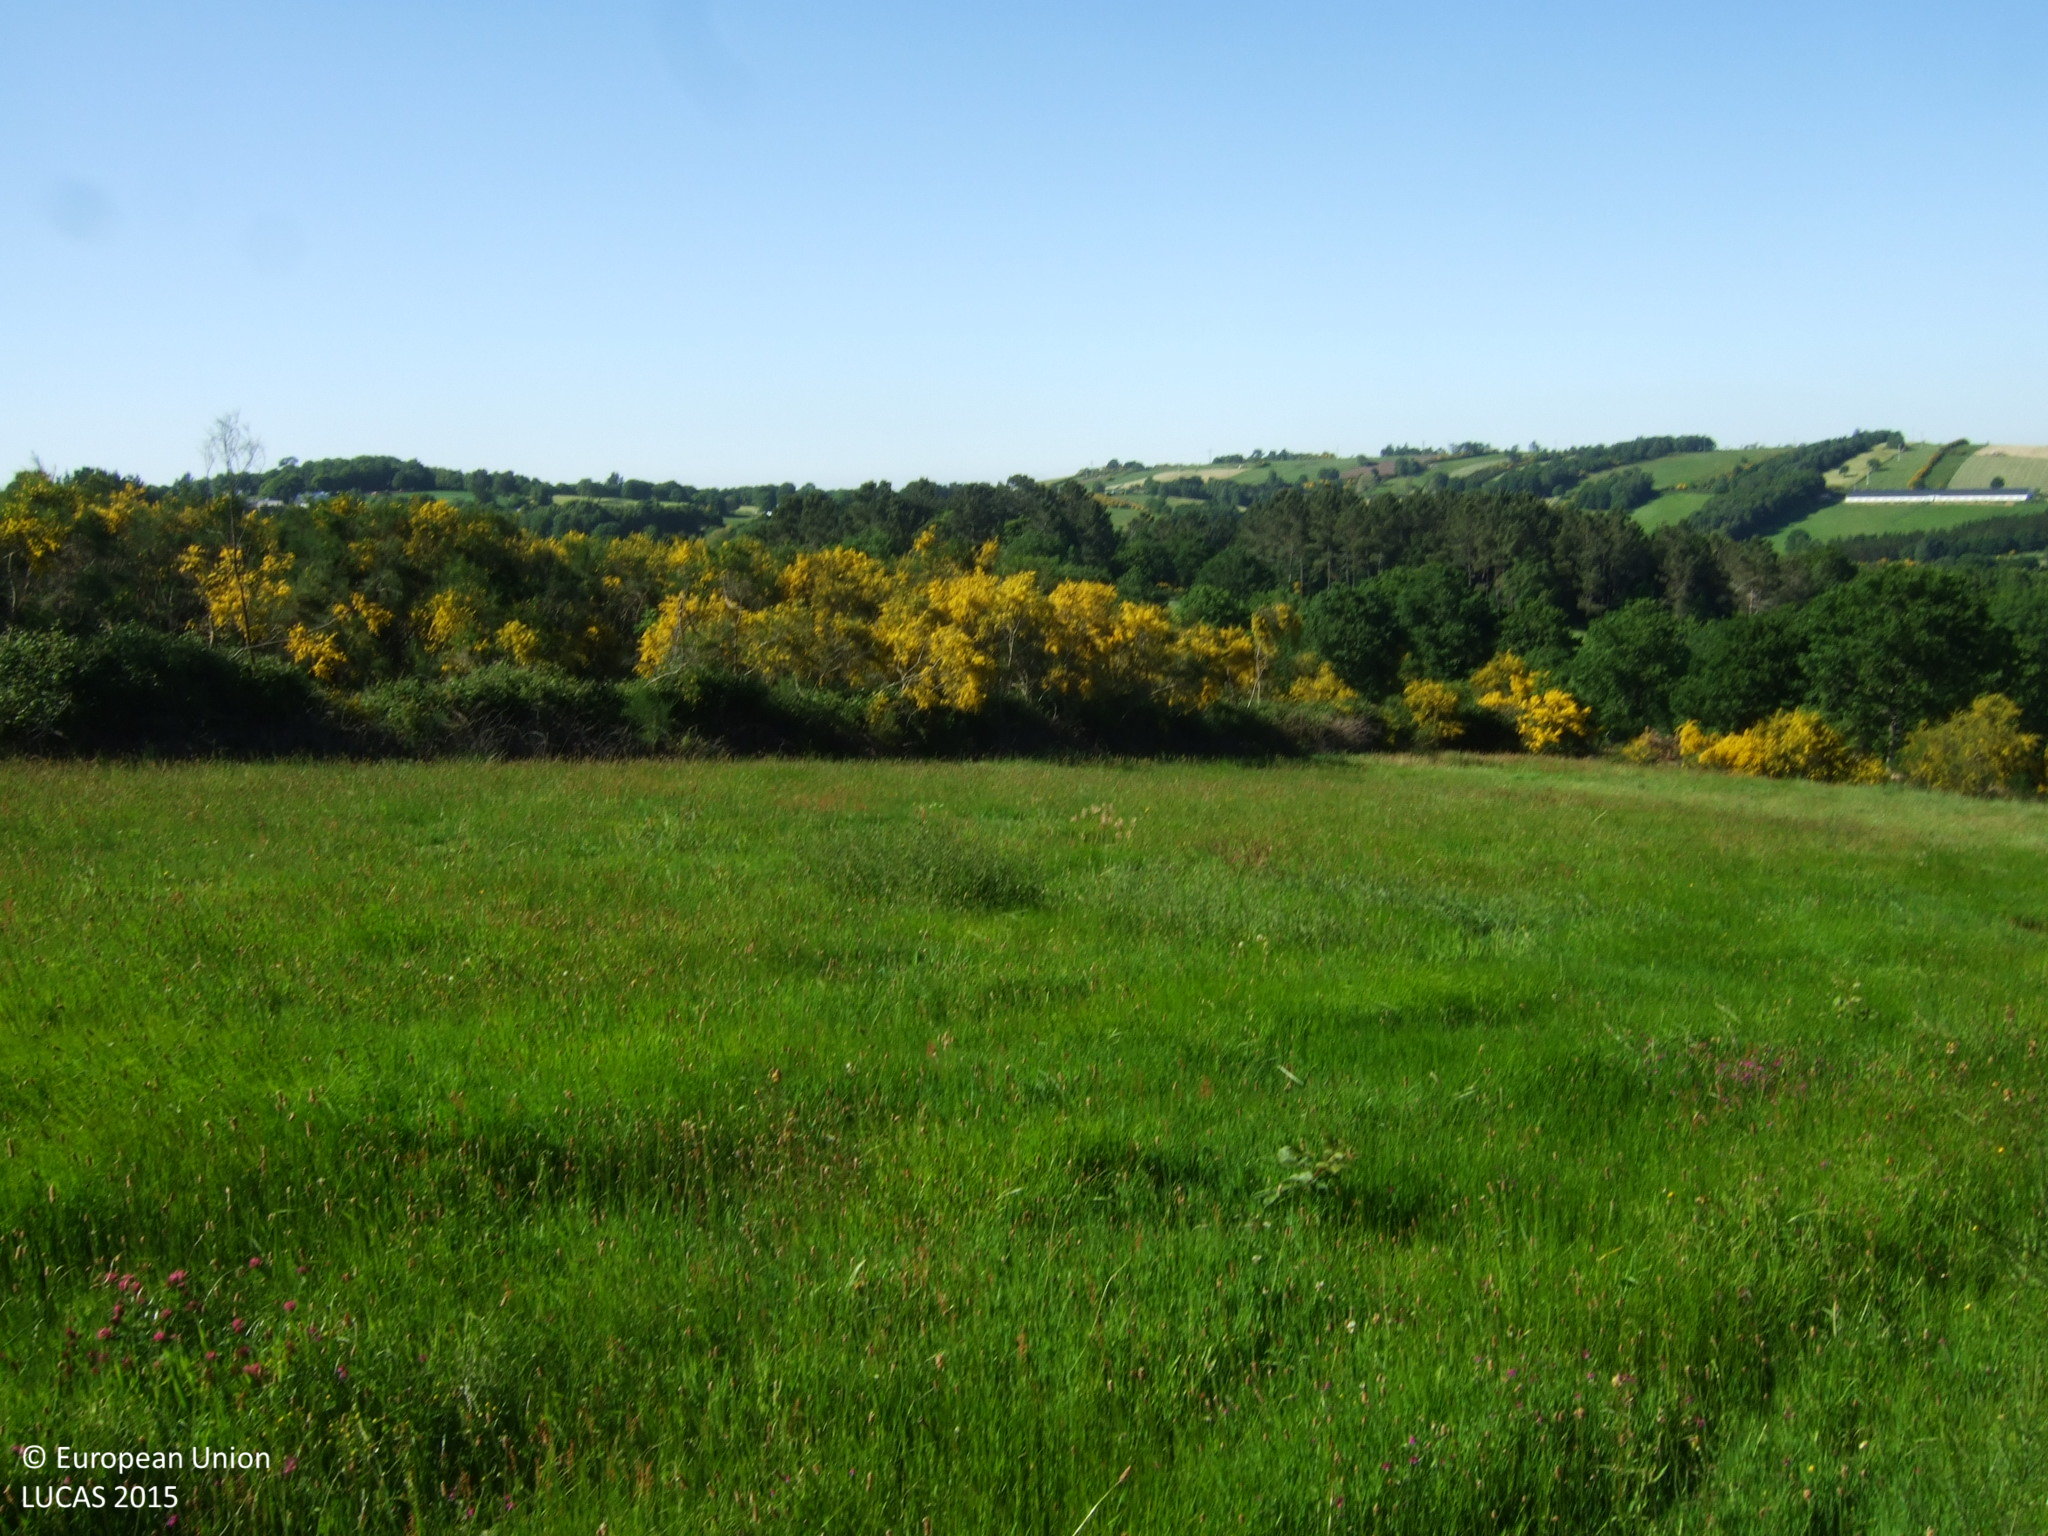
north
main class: Woodland
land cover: Pine dominated coniferous woodland
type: exotic forest
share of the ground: > 75 %
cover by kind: coniferous forest trees 75 %, shrubs 25 %
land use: Forestry
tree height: < 5 m
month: May
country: ES
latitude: 42.6905
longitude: -7.5641
